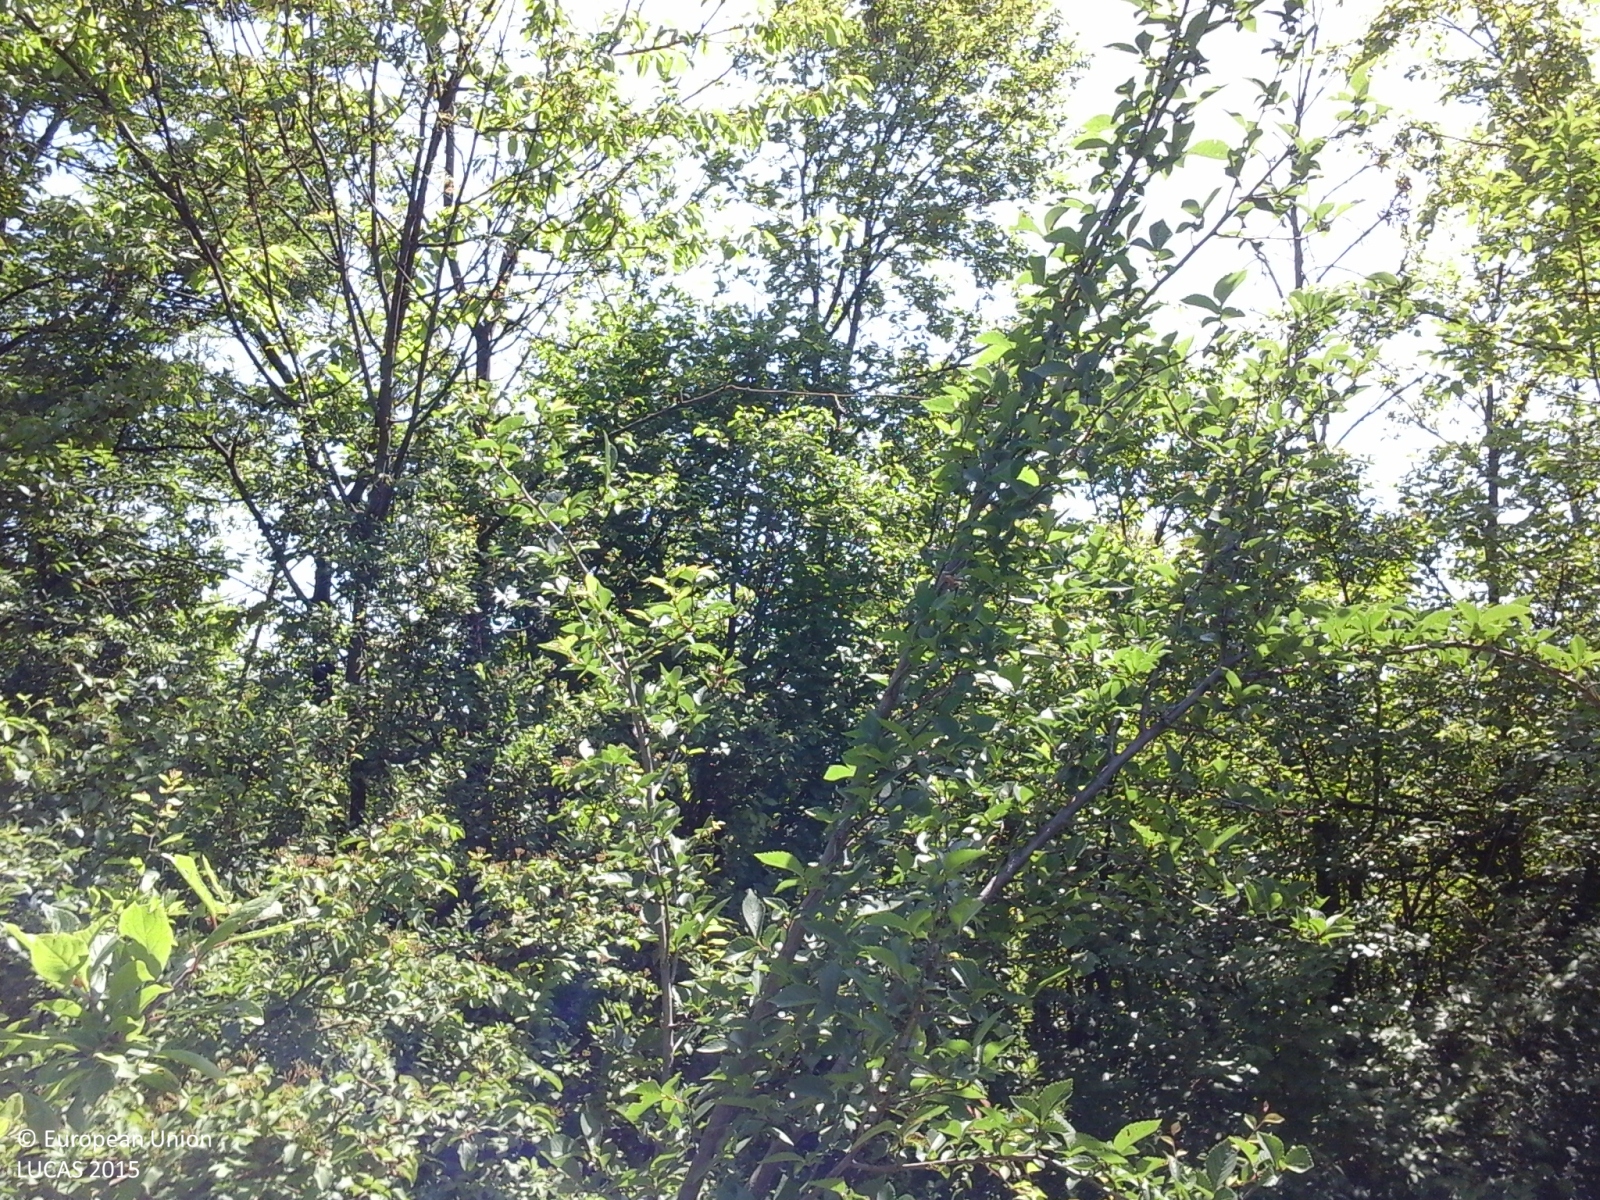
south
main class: Woodland
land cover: Broadleaved woodland
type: thermophilous deciduous forest
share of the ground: > 75 %
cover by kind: broadleaved forest trees 75 %, shrubs 25 %
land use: Forestry
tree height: > 5 m
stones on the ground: < 10 %
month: May
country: IT
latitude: 44.7653
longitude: 10.0630
